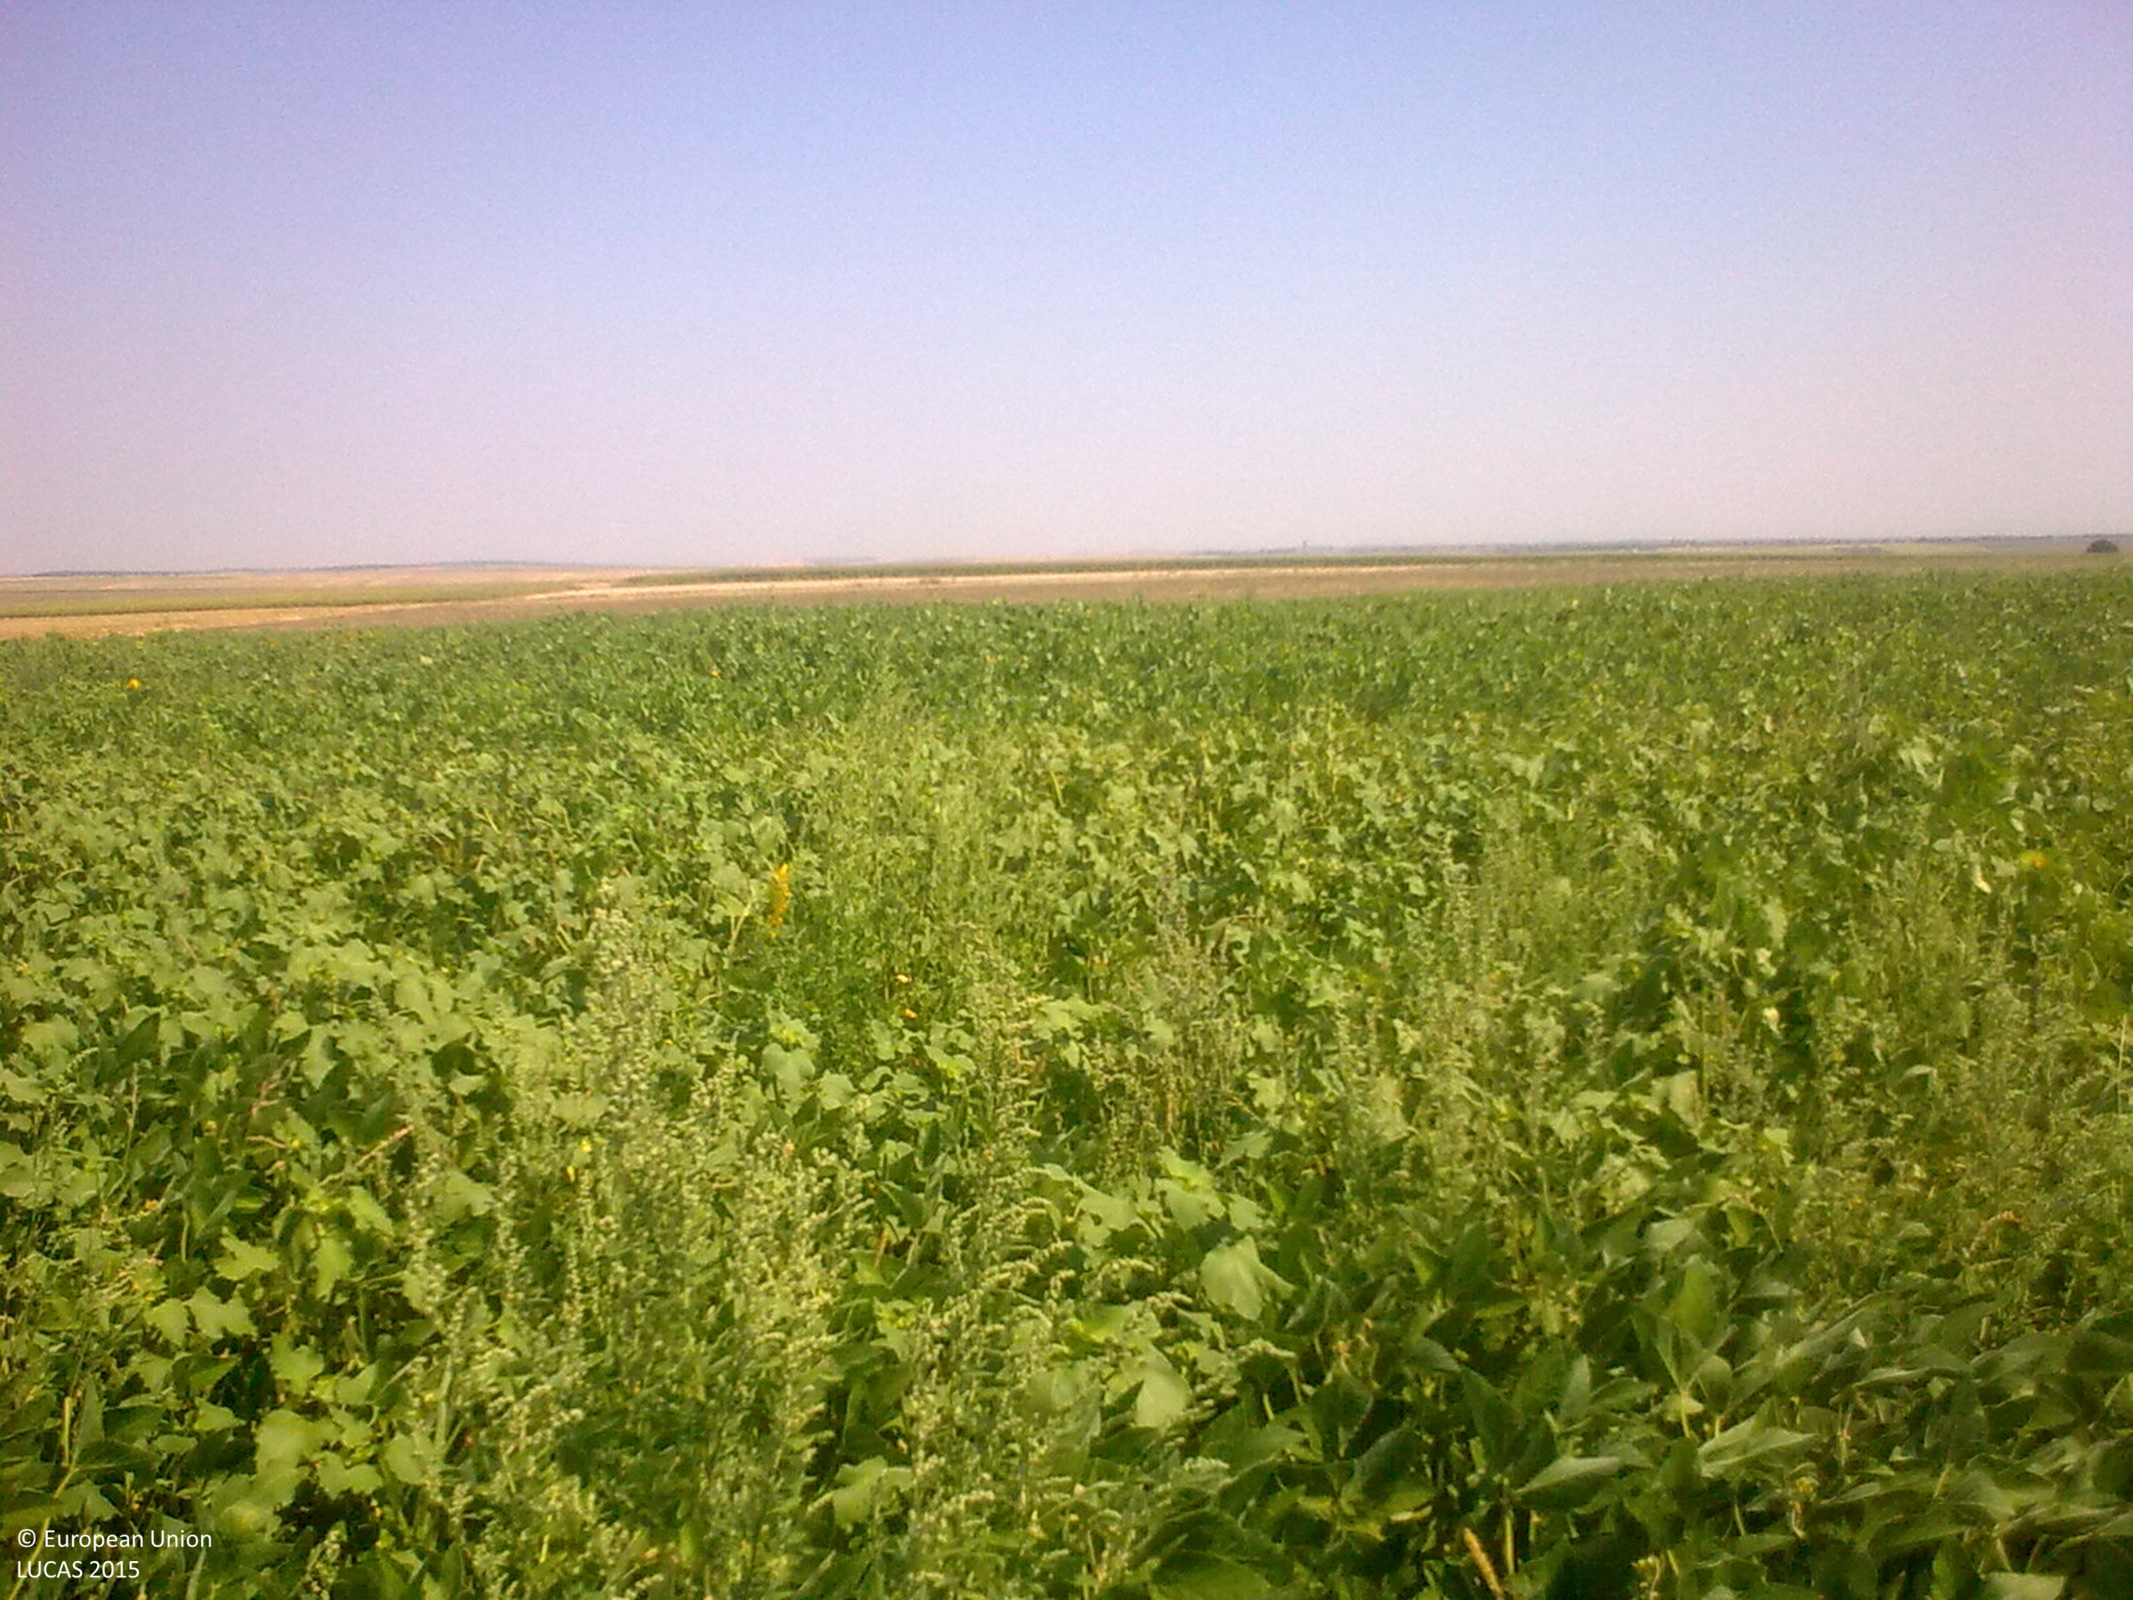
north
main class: Cropland
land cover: Soya
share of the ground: > 75 %
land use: Agriculture (excluding fallow land and kitchen gardens)
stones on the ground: < 10 %
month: July
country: BG
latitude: 43.7733
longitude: 26.2652
